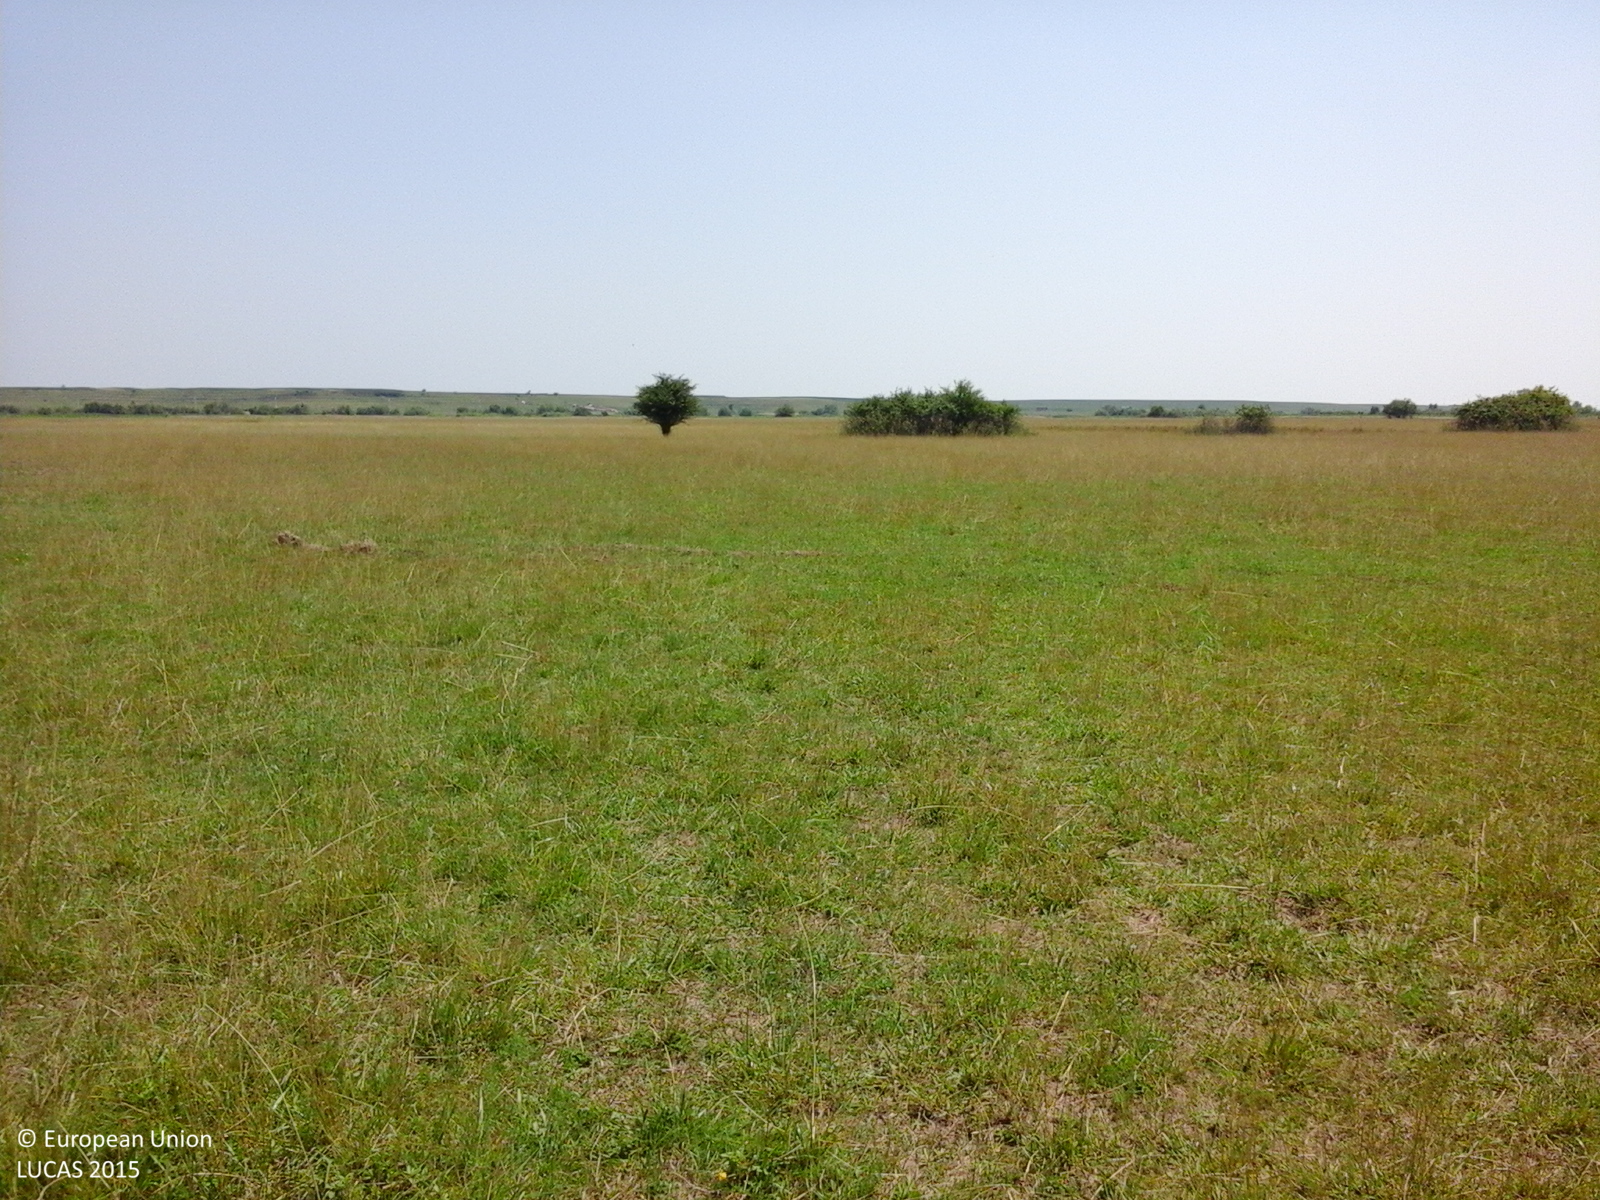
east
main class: Grassland
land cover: Grassland without tree/shrub cover
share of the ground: > 75 %
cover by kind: herbaceous plants 100 %
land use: Agriculture (excluding fallow land and kitchen gardens)
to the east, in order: Grassland without tree/shrub cover; Single bushes/trees; Grassland without tree/shrub cover
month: July
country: RO
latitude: 44.5609
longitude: 24.9494
